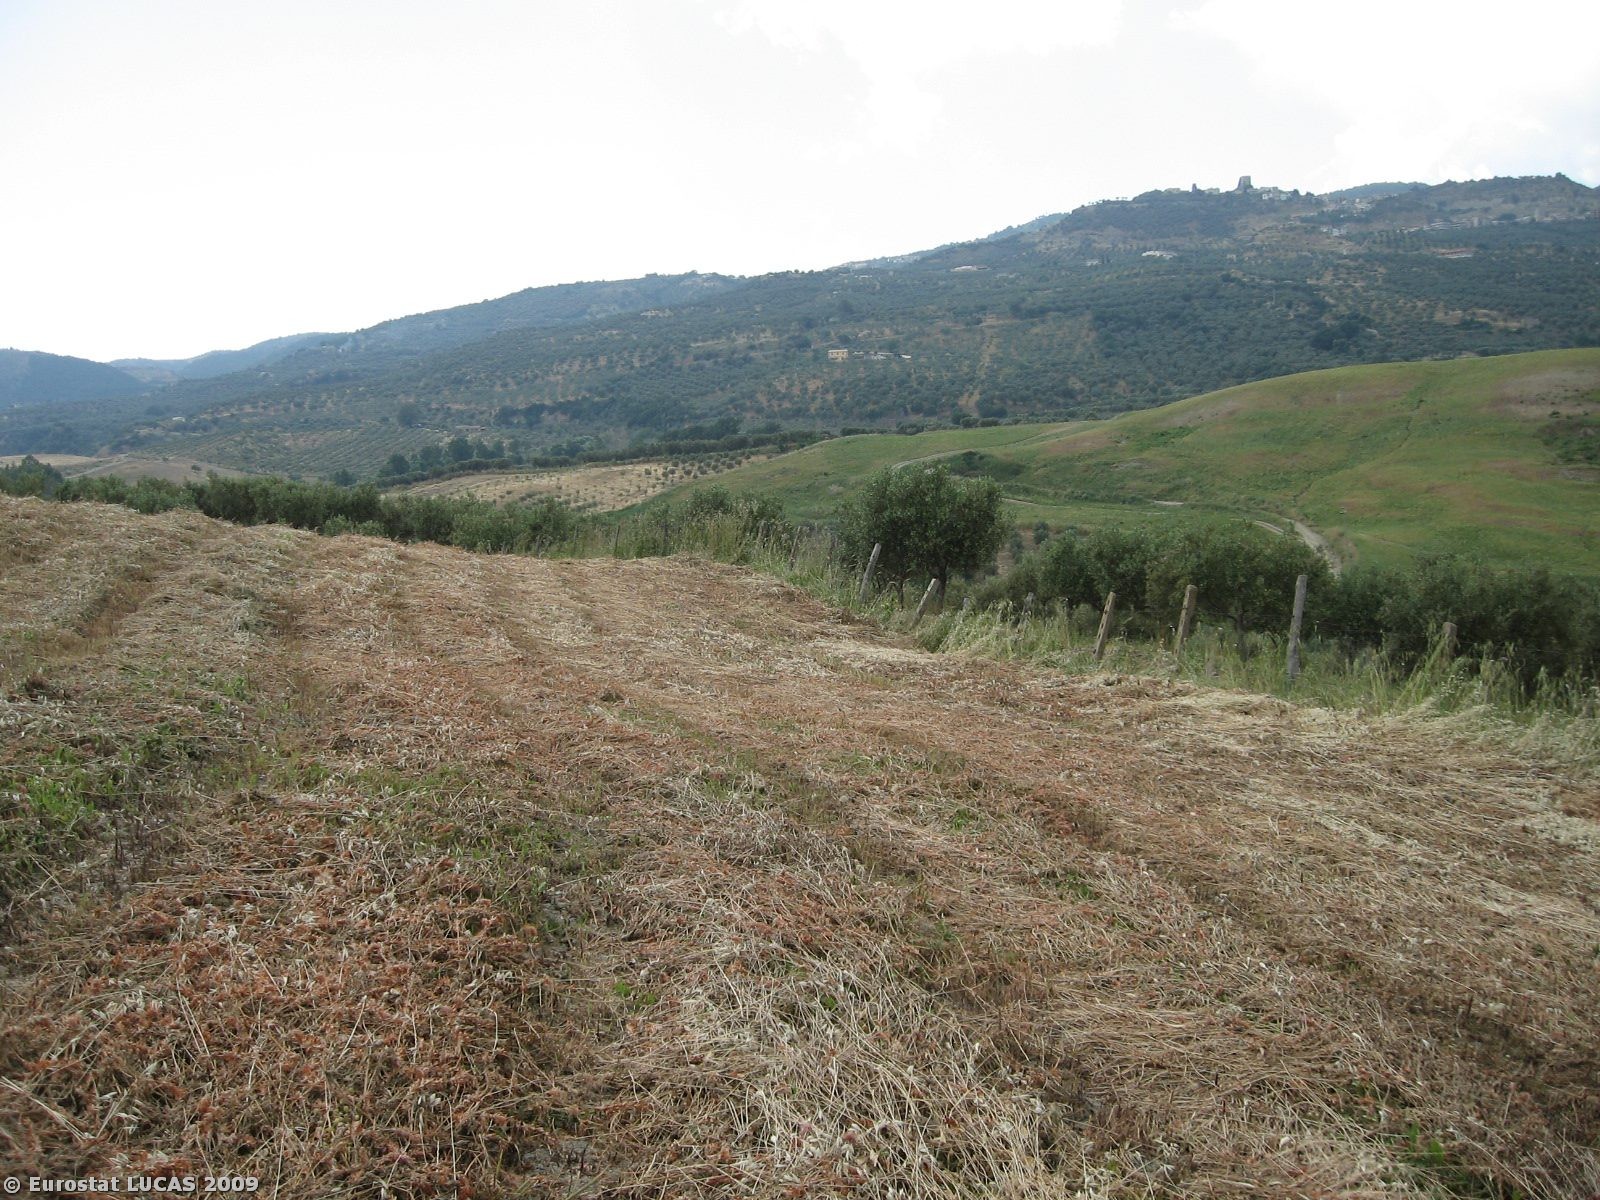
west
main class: Cropland
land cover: Temporary grasslands
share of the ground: > 75 %
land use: Agriculture (excluding fallow land and kitchen gardens)
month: May
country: IT
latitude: 39.0128
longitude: 16.8147
